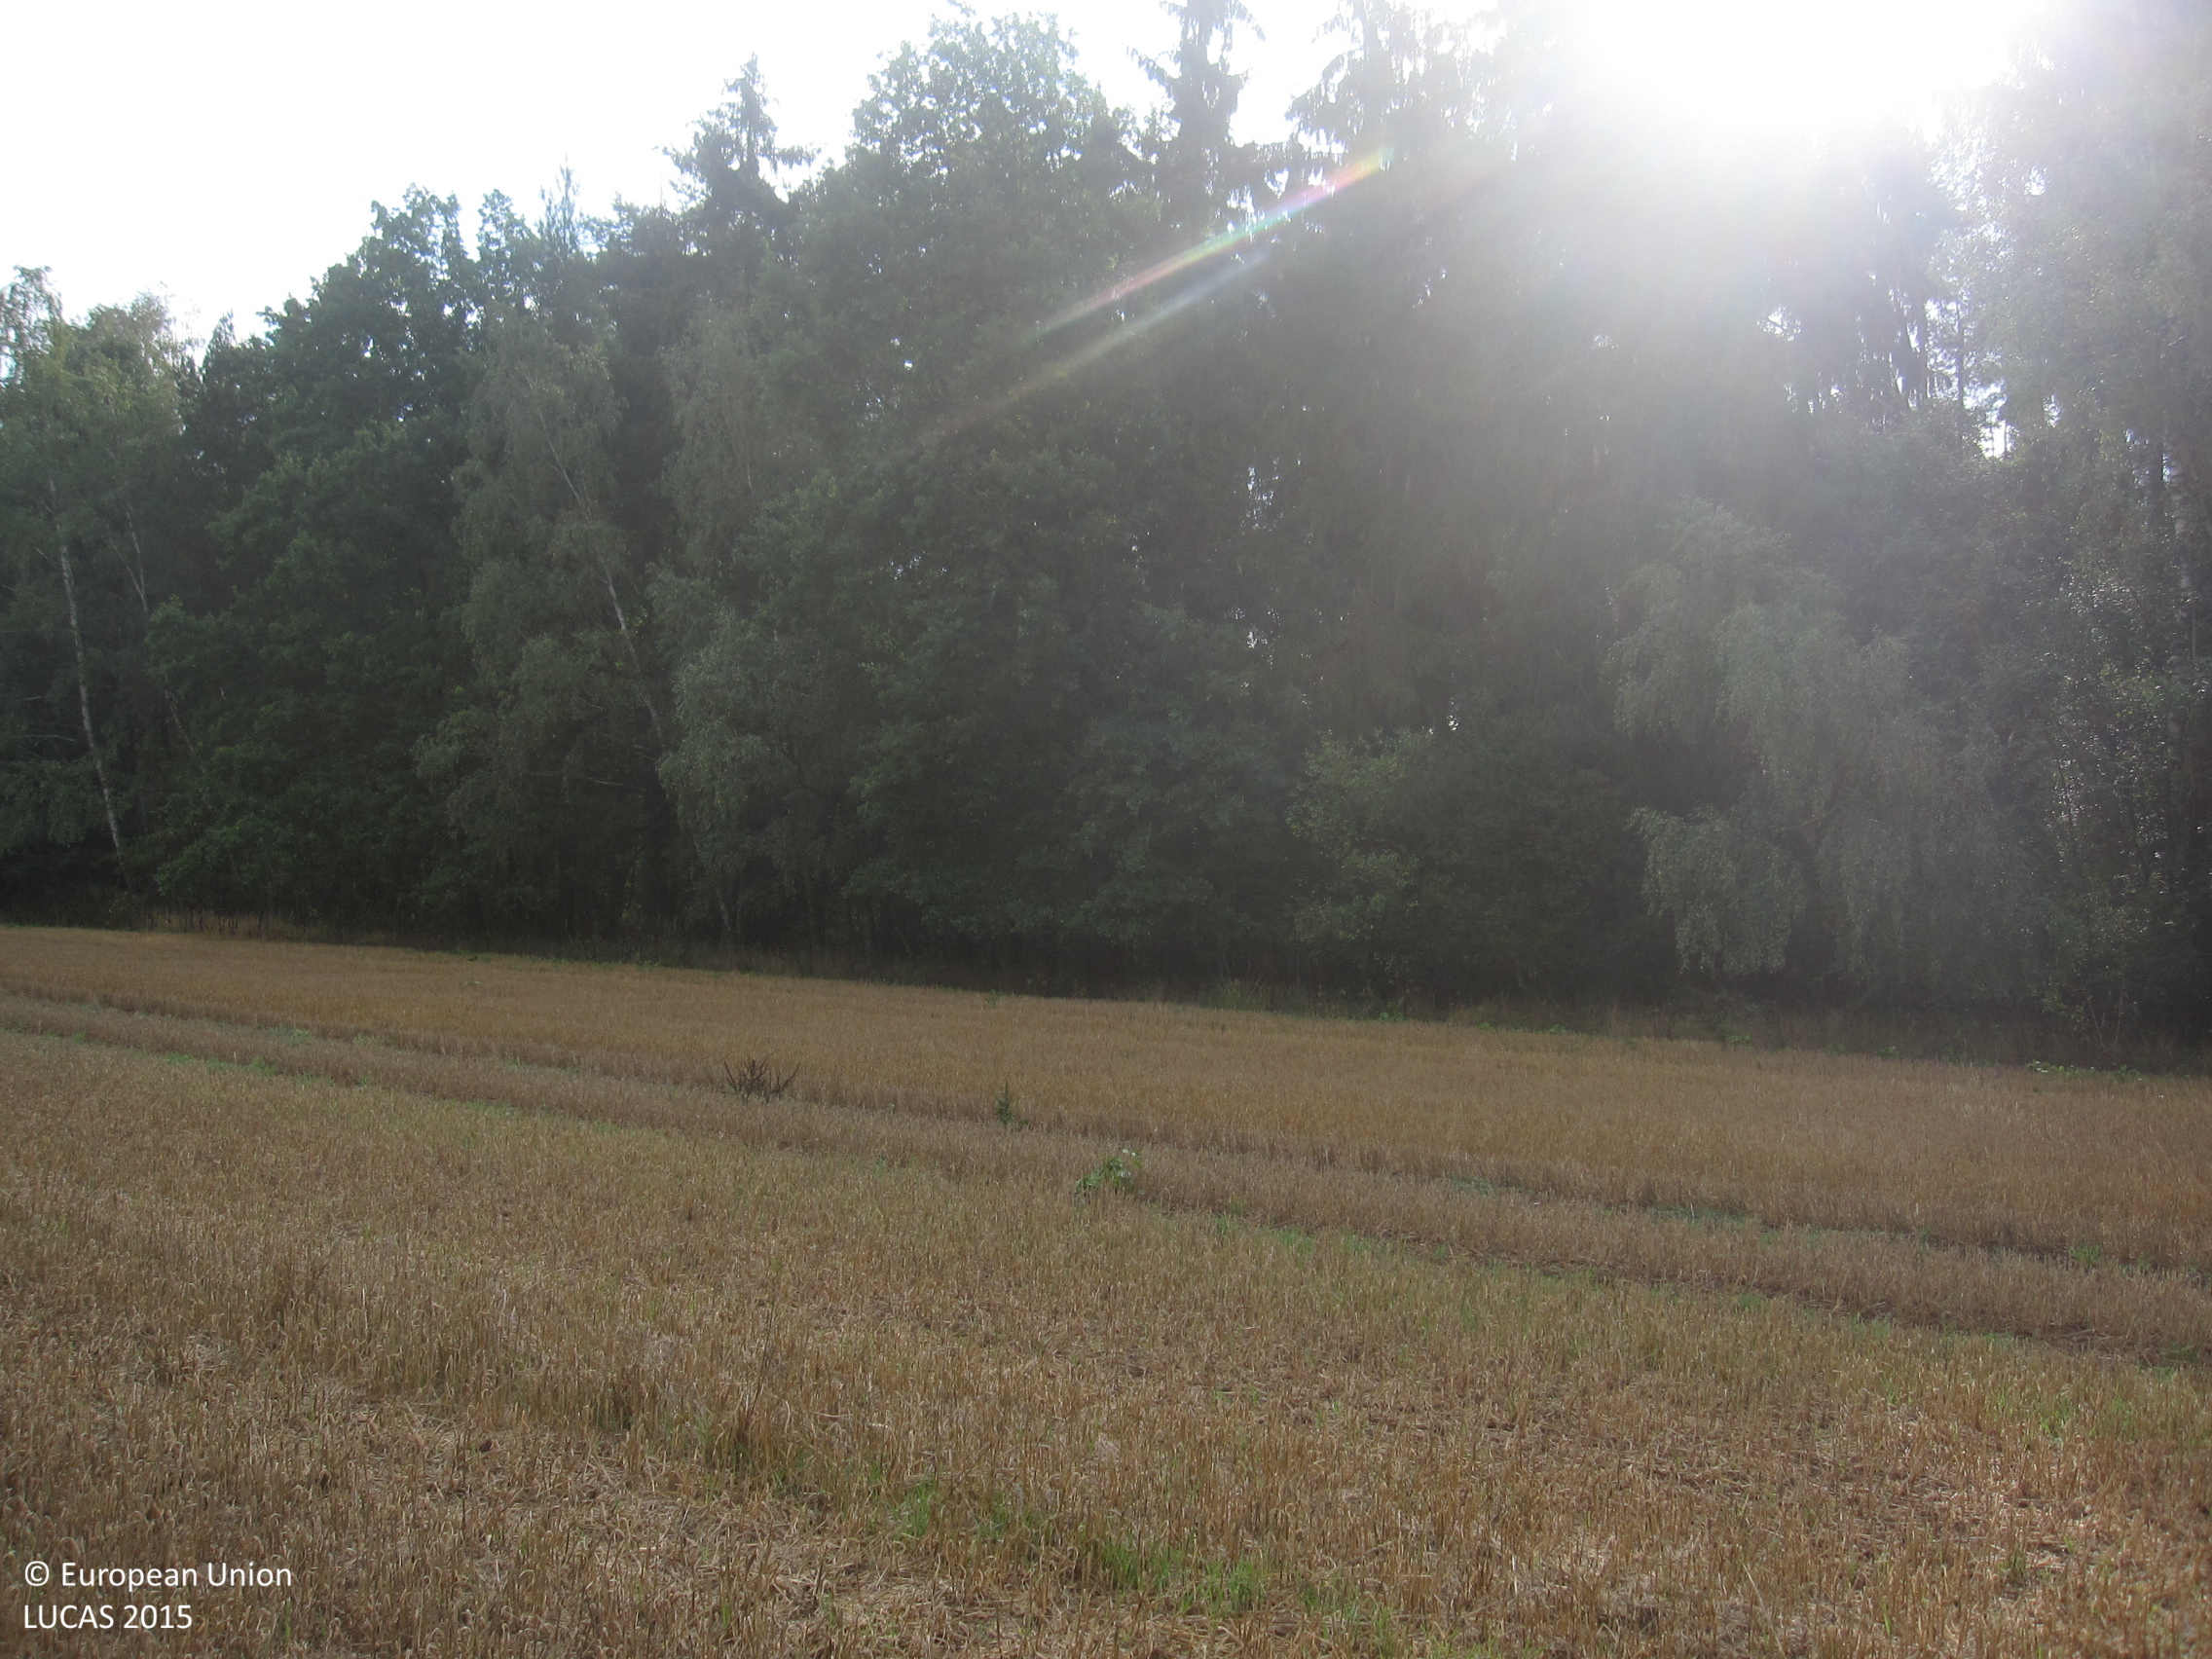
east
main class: Cropland
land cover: Common wheat
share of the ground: 50 - 75 %
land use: Agriculture (excluding fallow land and kitchen gardens)
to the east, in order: Common wheat; Pine dominated mixed woodland; Common wheat; Tracks; Pine dominated coniferous woodland
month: August
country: DE
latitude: 50.7962
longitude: 12.0001
